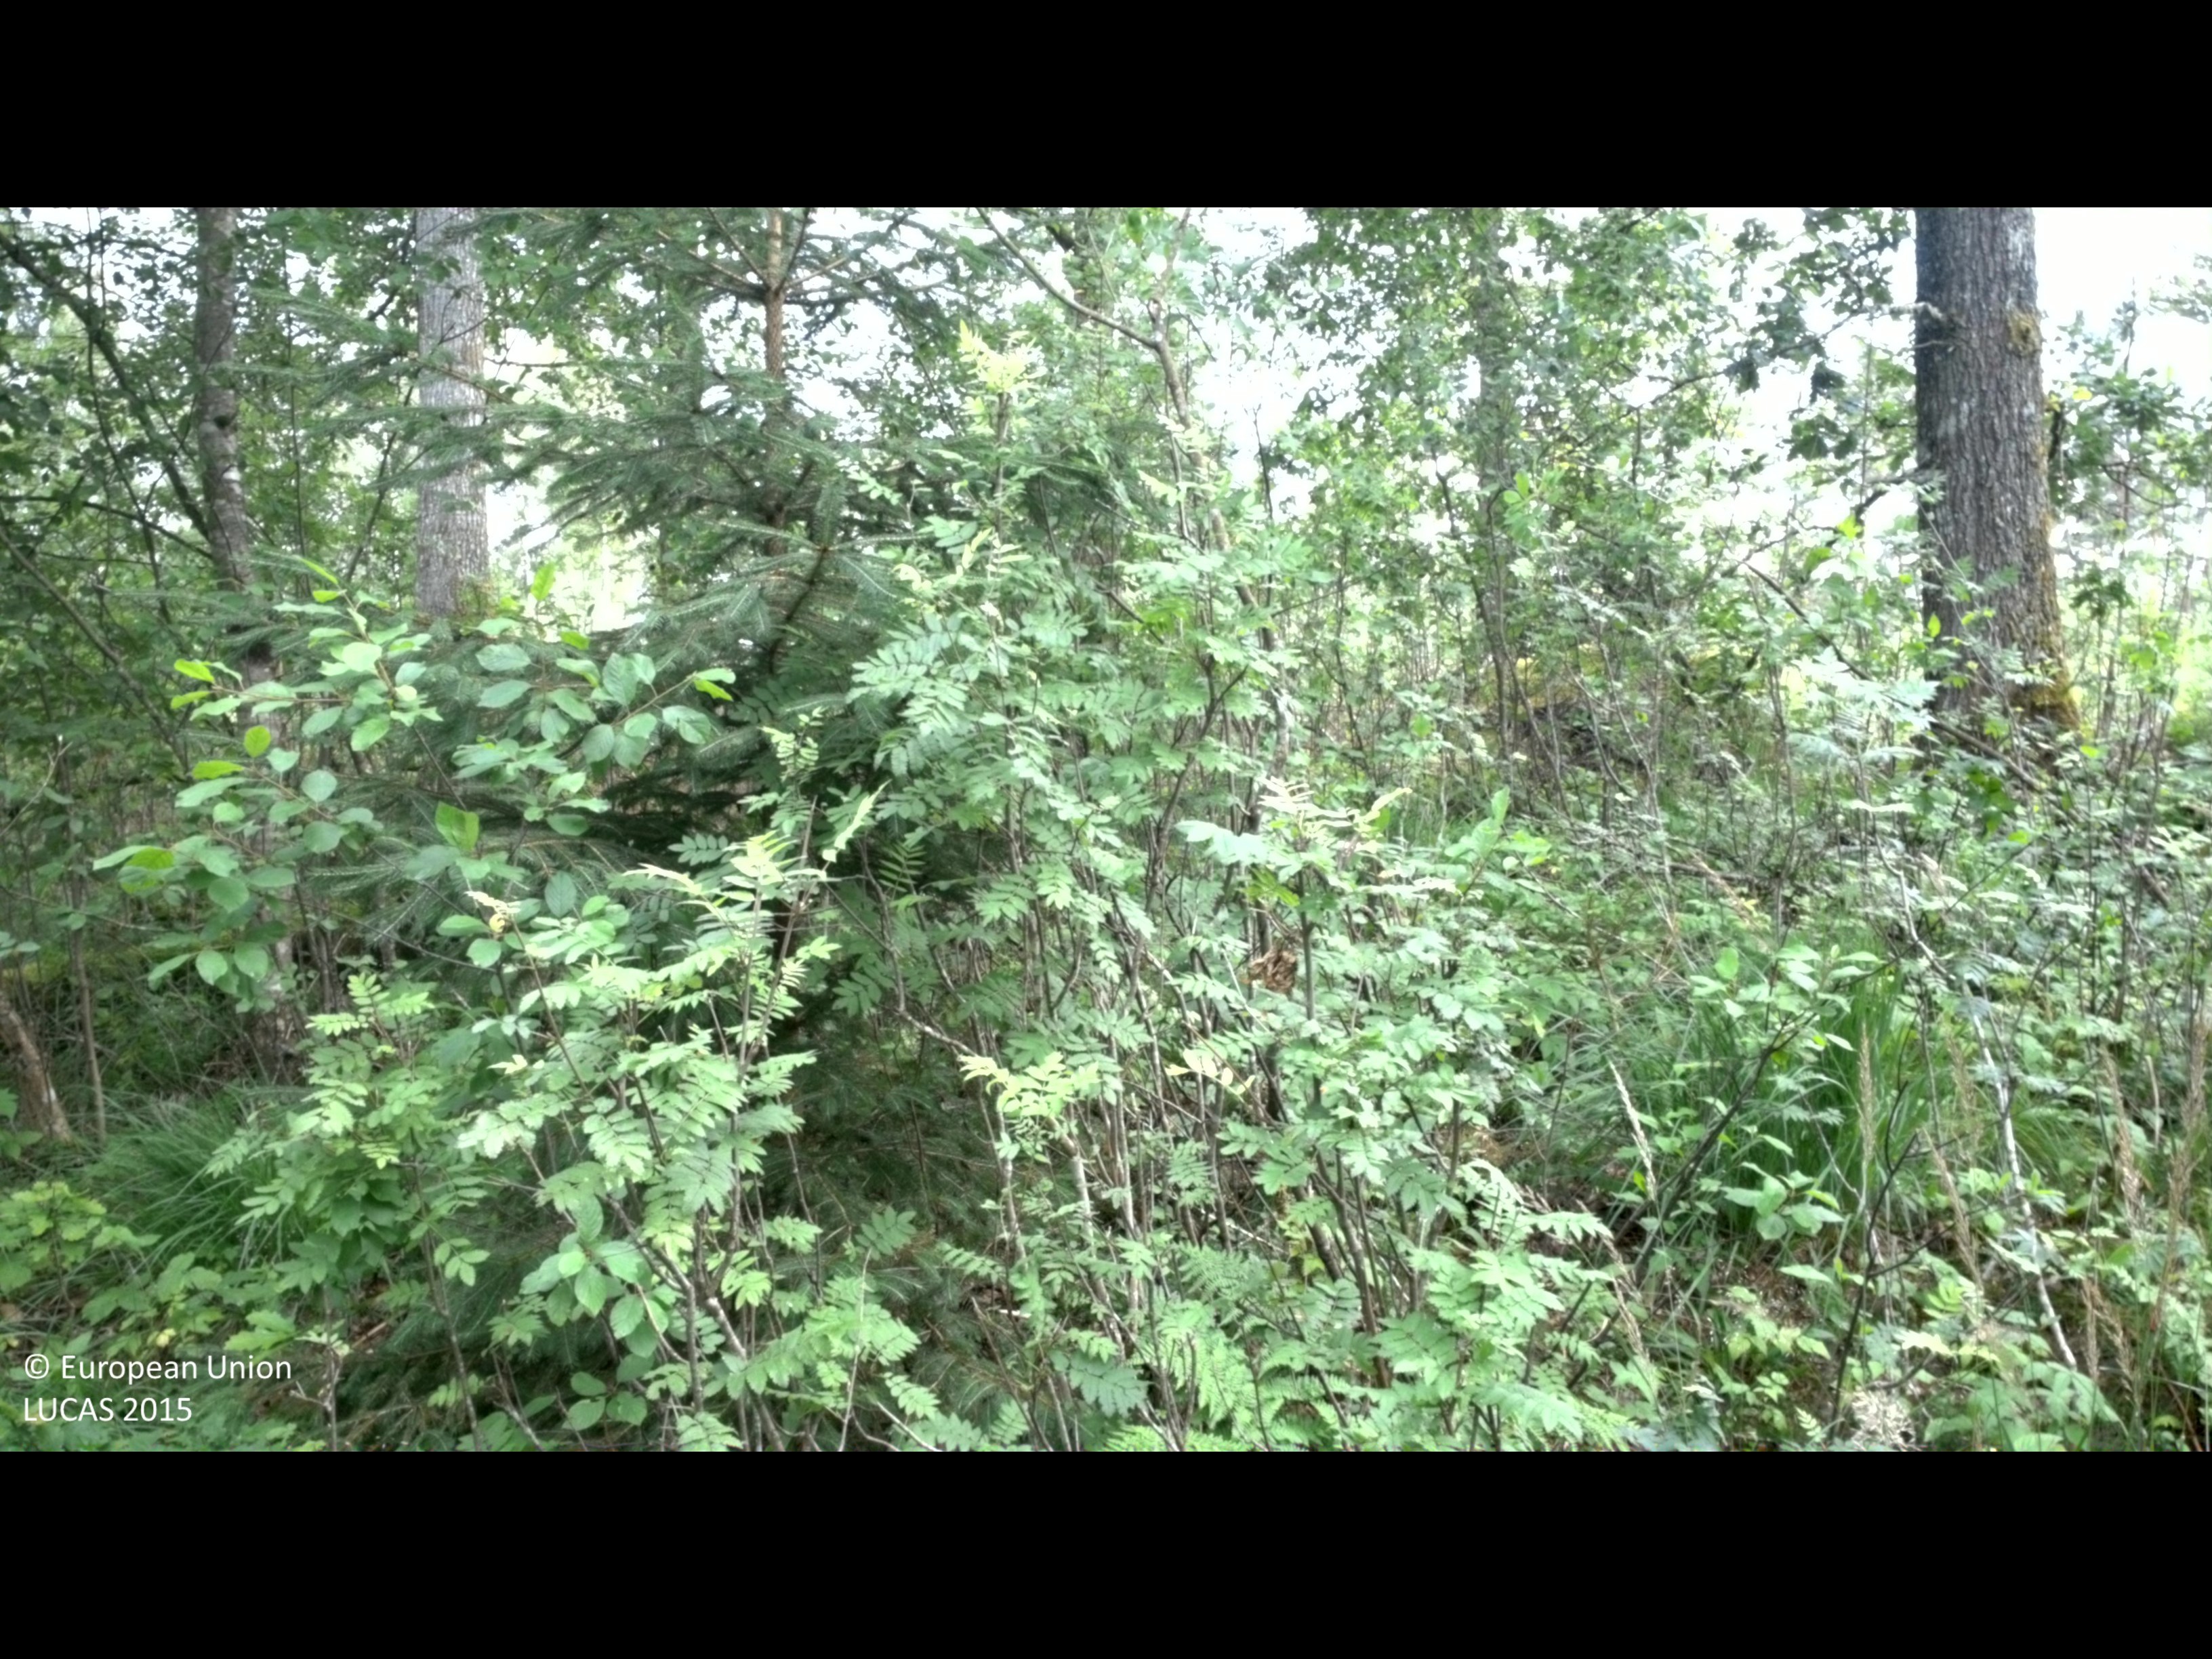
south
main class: Woodland
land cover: Broadleaved woodland
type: boreal forest
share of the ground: 50 - 75 %
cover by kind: broadleaved forest trees 55 %, herbaceous plants 30 %, shrubs 15 %
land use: Forestry
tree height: > 5 m
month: July
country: SE
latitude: 56.6546
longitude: 13.7648
